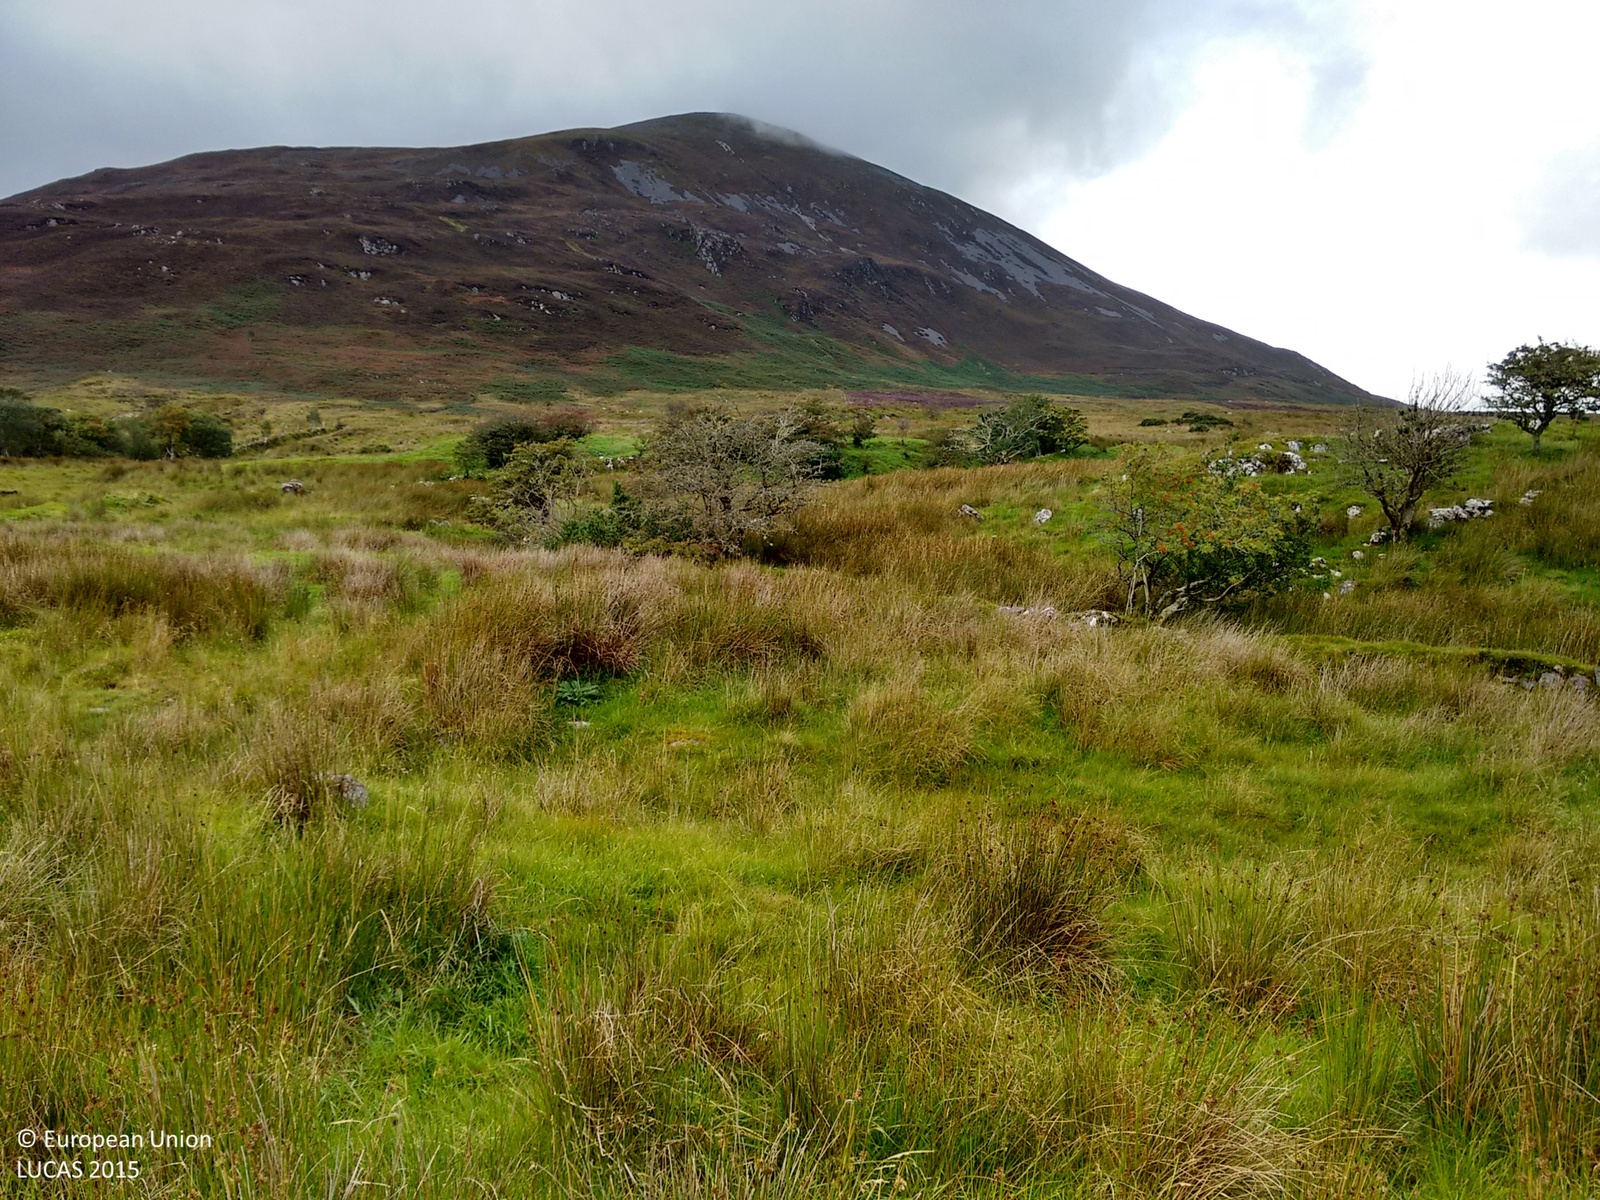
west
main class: Shrubland
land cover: Shrubland without tree cover
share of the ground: > 75 %
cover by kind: shrubs 60 %, lichens and mosses 30 %, herbaceous plants 10 %
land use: Agriculture (excluding fallow land and kitchen gardens)
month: September
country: IE
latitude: 54.0064
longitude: -9.3436
